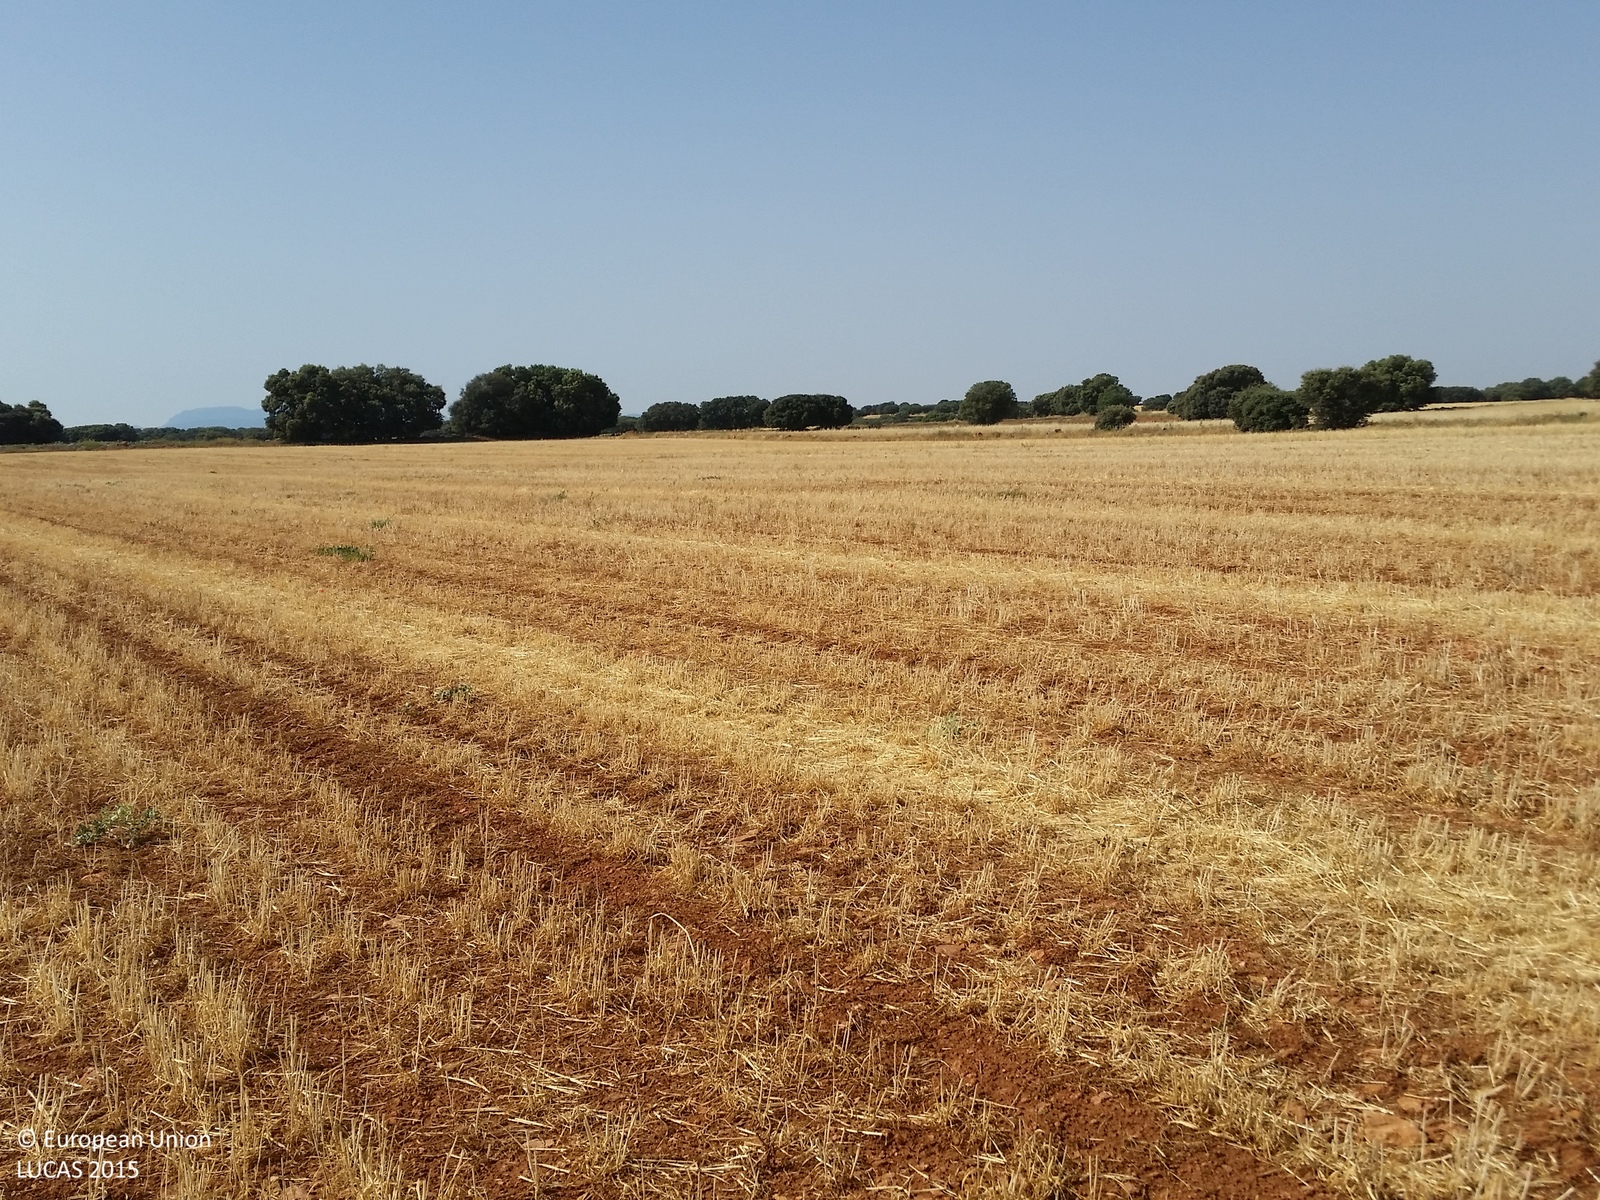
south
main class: Cropland
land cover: Barley
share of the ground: > 75 %
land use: Agriculture (excluding fallow land and kitchen gardens)
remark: Harvested field
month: June
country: ES
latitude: 38.7587
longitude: -2.5811
